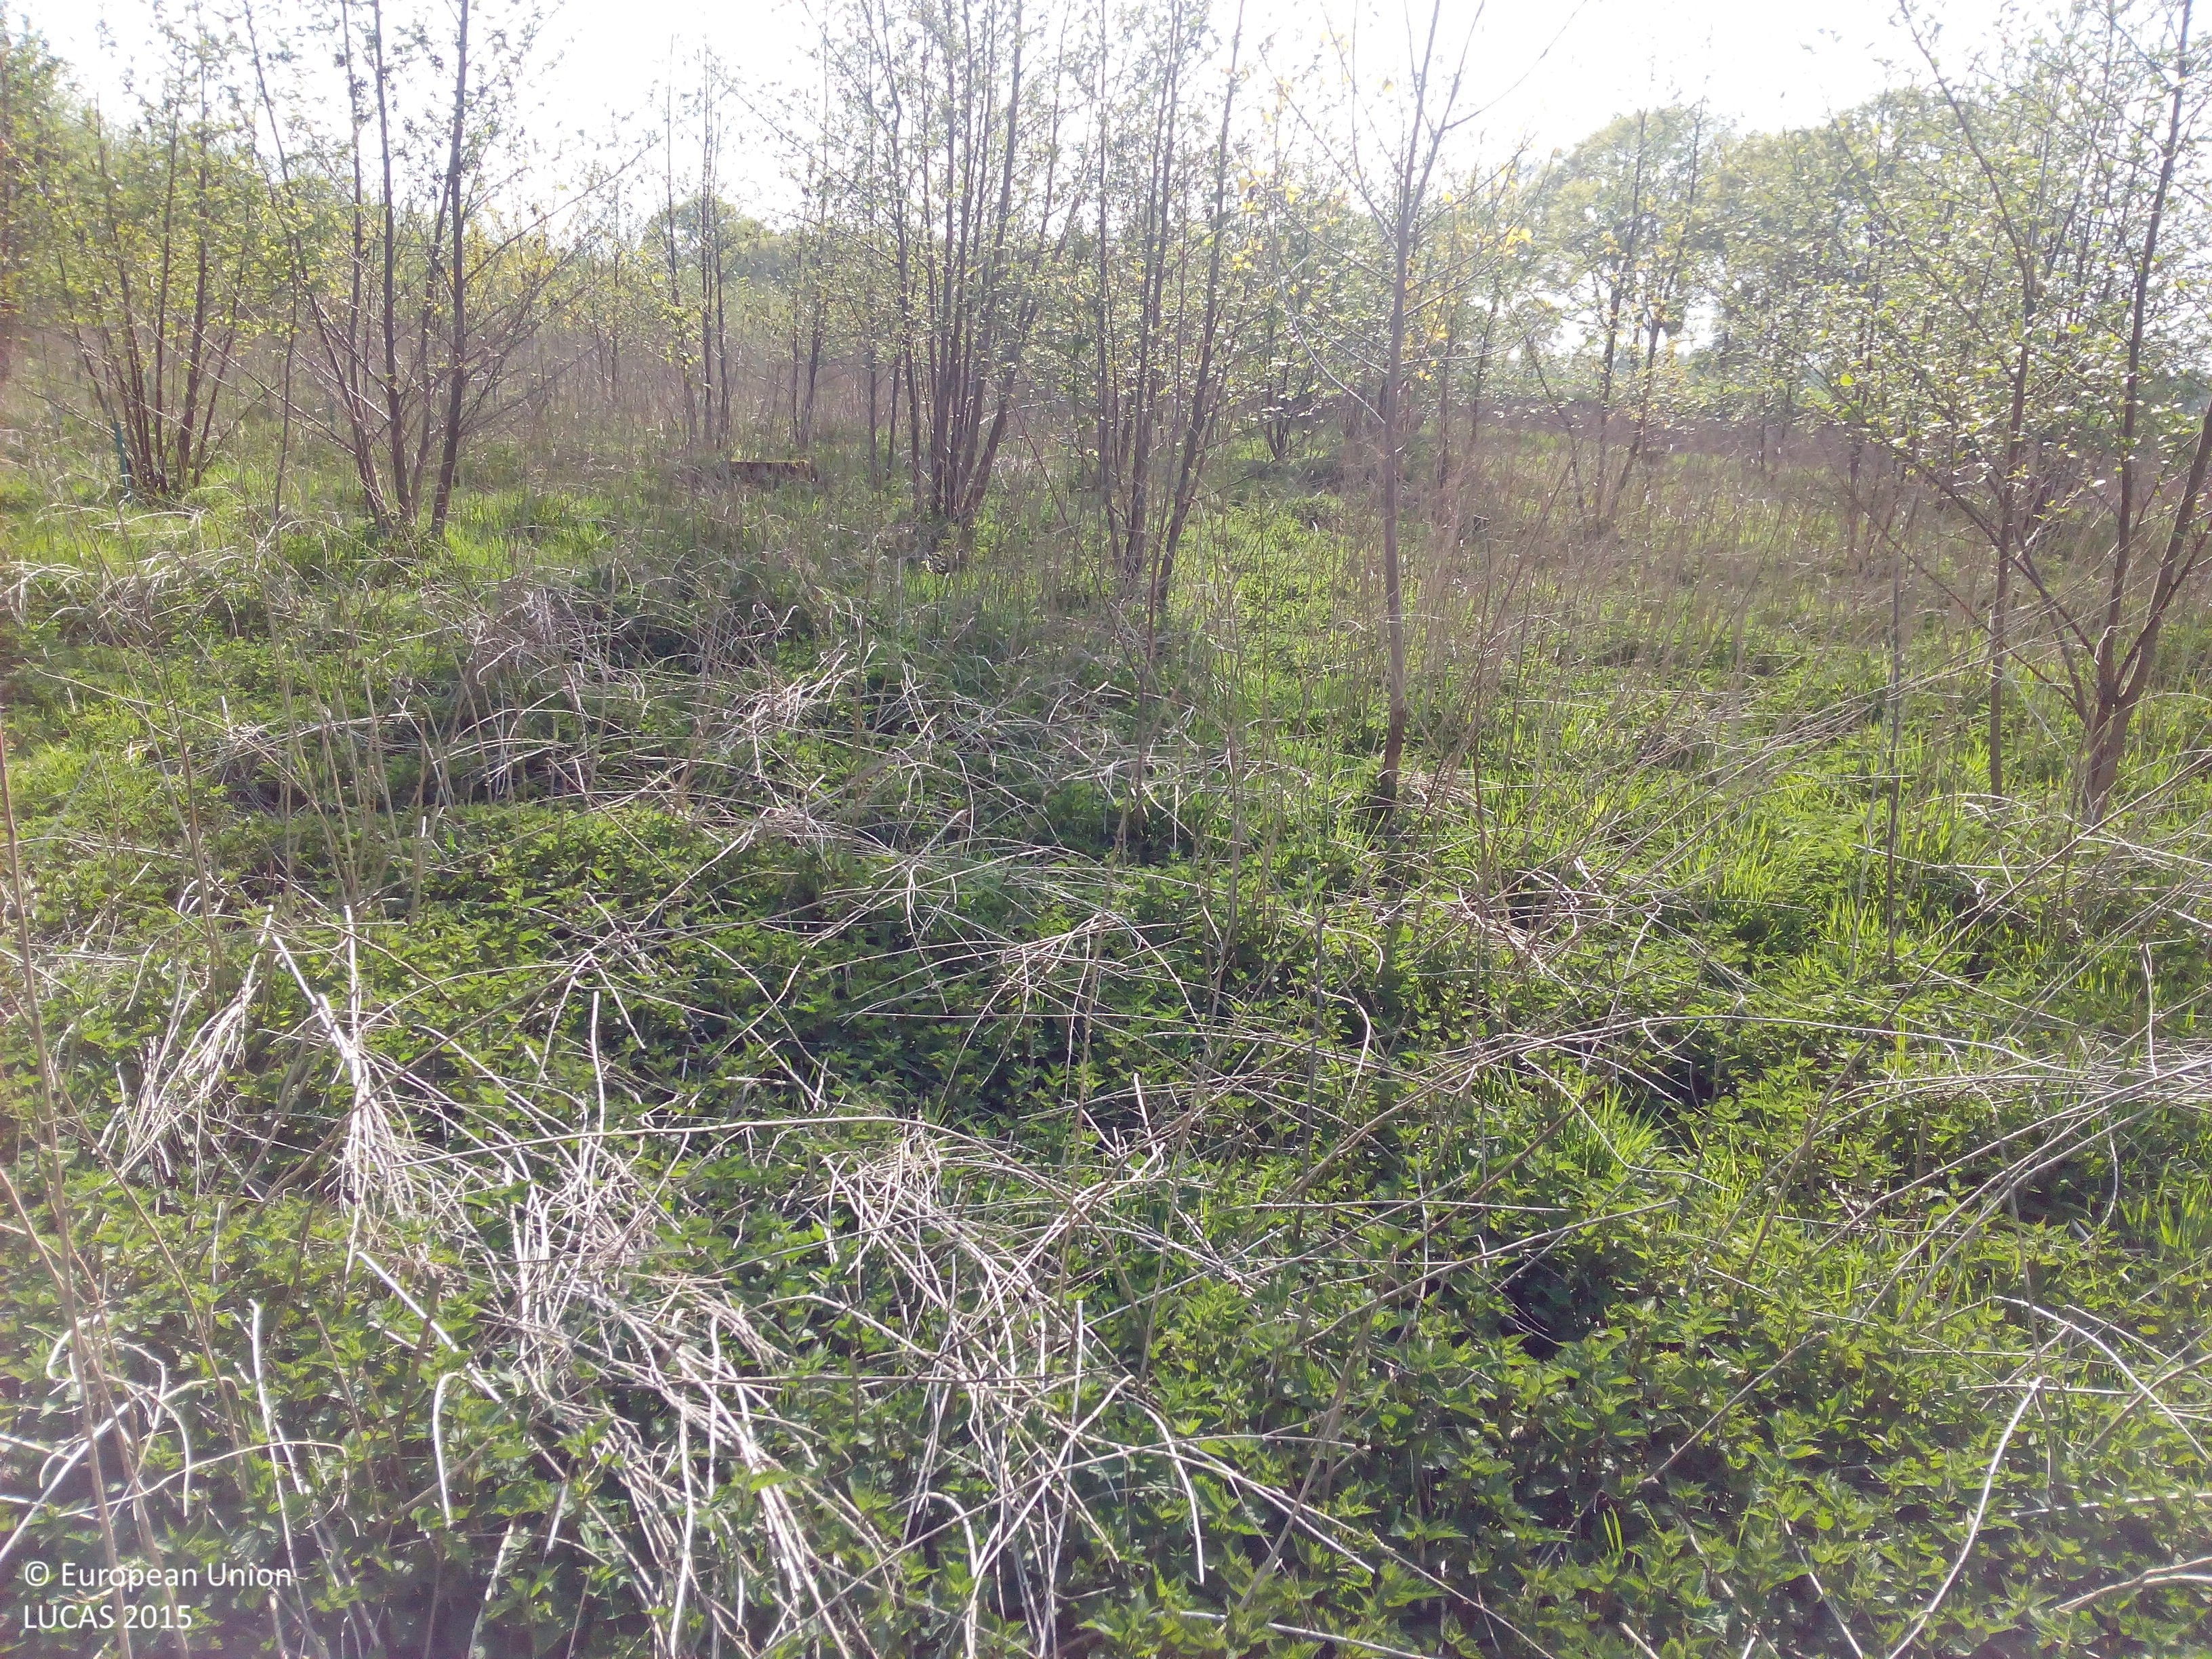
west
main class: Woodland
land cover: Broadleaved woodland
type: mesophytic deciduous forest
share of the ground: 10 - 25 %
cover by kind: herbaceous plants 80 %, broadleaved forest trees 20 %
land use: Forestry
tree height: > 5 m
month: May
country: DE
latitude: 52.1521
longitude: 7.4426
